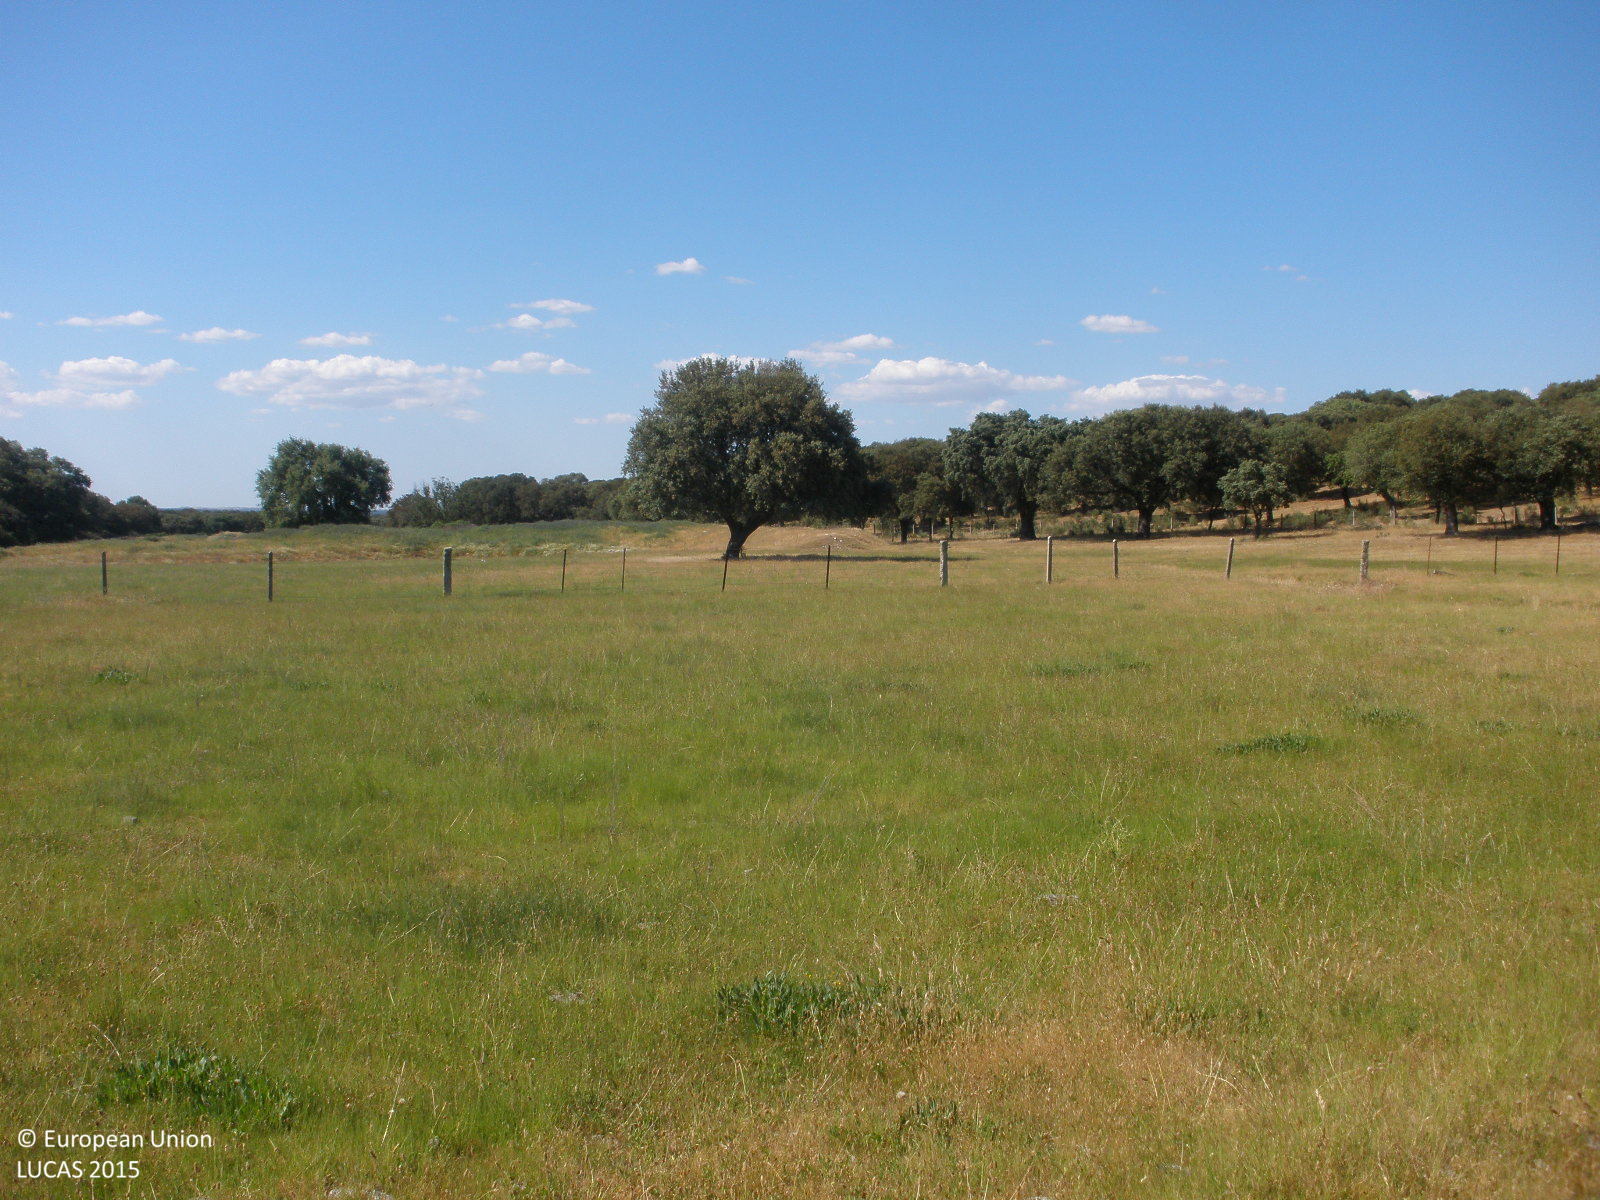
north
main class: Grassland
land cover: Grassland without tree/shrub cover
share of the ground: > 75 %
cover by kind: herbaceous plants 100 %
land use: Agriculture (excluding fallow land and kitchen gardens)
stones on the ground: < 10 %
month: June
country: ES
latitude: 40.4884
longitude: -6.6669
